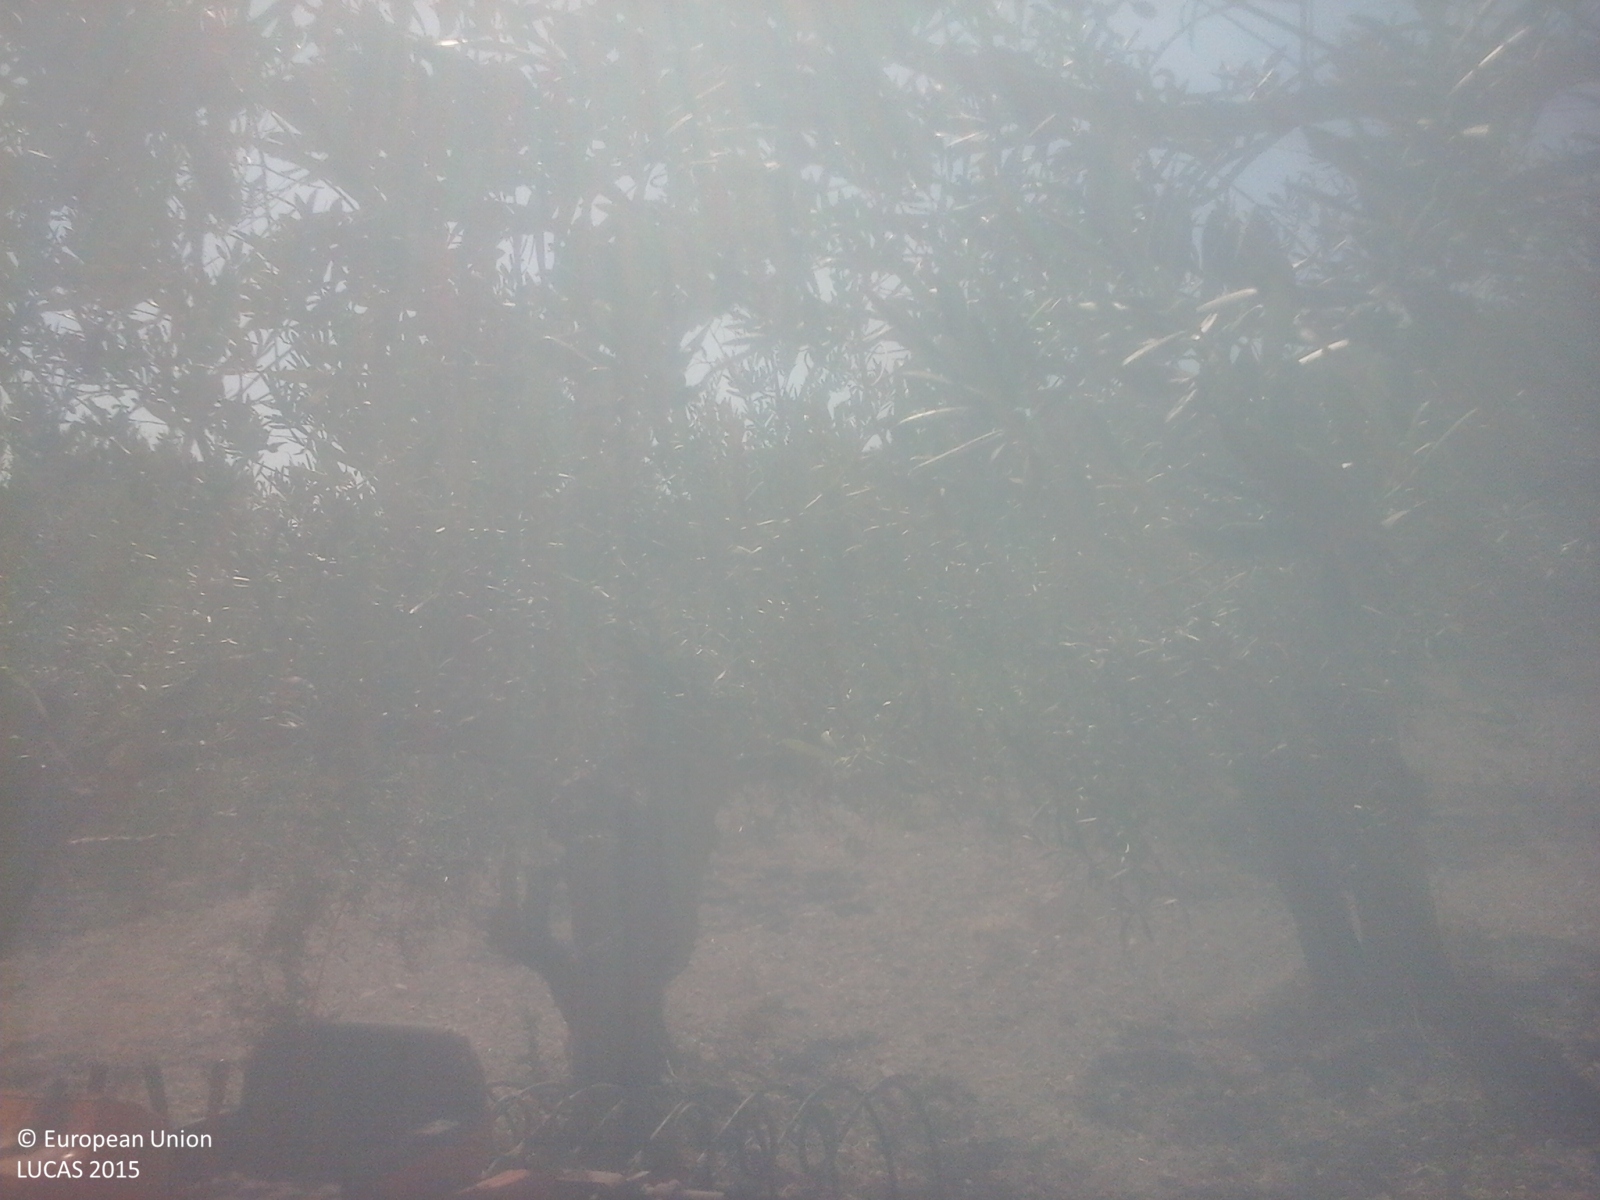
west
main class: Cropland
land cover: Olive groves
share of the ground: 25 - 50 %
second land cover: Other bare soil
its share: > 75 %
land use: Agriculture (excluding fallow land and kitchen gardens)
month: July
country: IT
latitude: 37.5657
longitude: 13.2248
